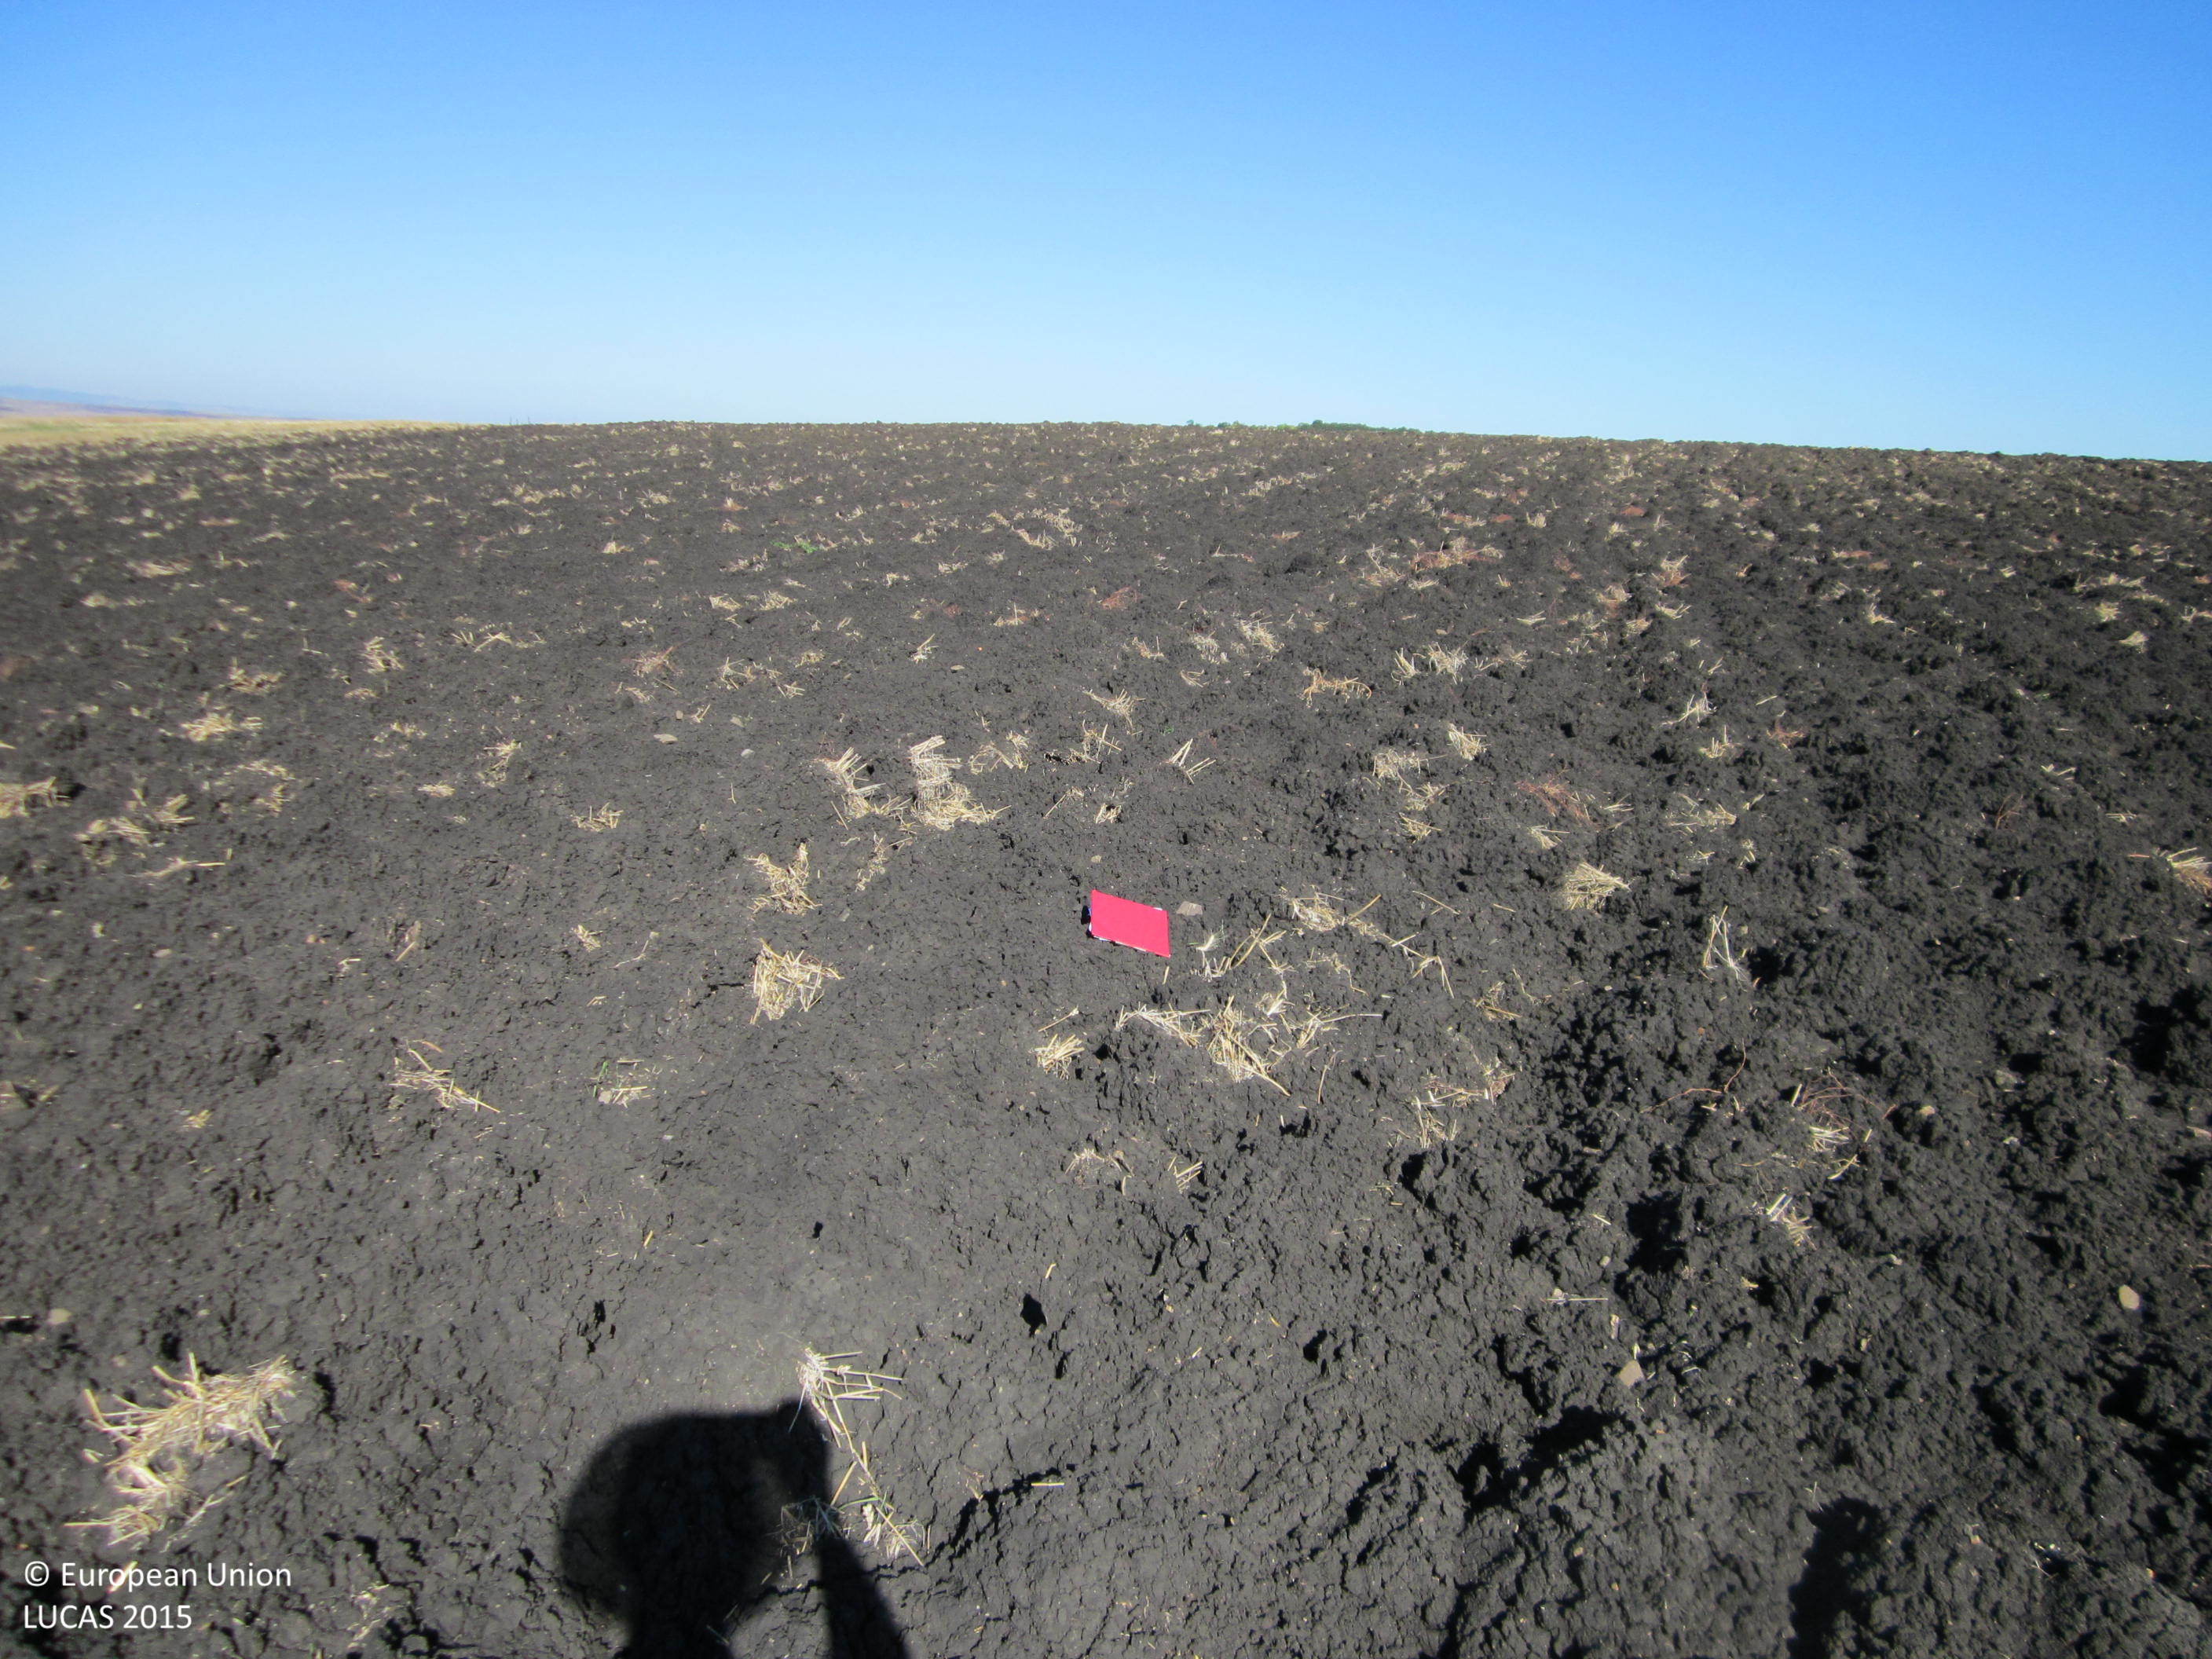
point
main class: Cropland
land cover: Common wheat
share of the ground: < 10 %
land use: Agriculture (excluding fallow land and kitchen gardens)
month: September
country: BG
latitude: 42.4629
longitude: 27.0710
